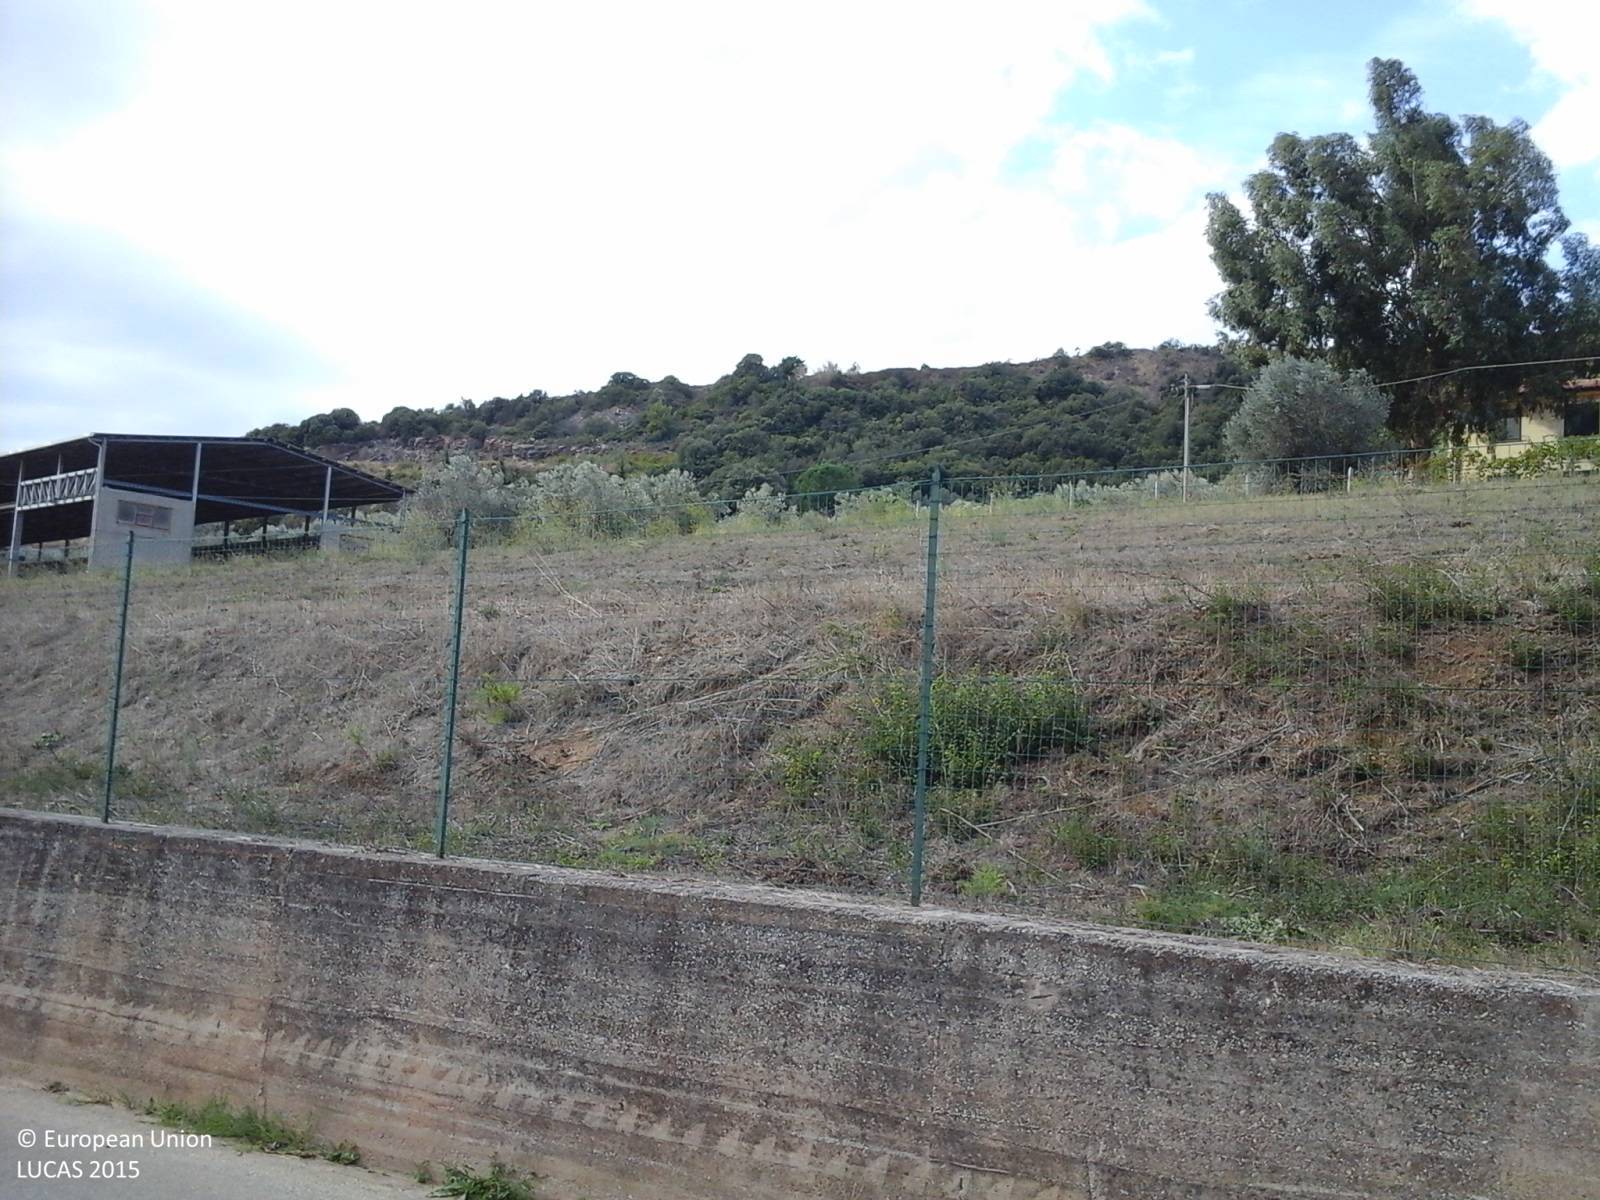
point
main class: Grassland
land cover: Grassland without tree/shrub cover
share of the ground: 50 - 75 %
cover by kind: herbaceous plants 100 %
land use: Agriculture (excluding fallow land and kitchen gardens)
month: September
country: IT
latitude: 43.0495
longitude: 10.5997
